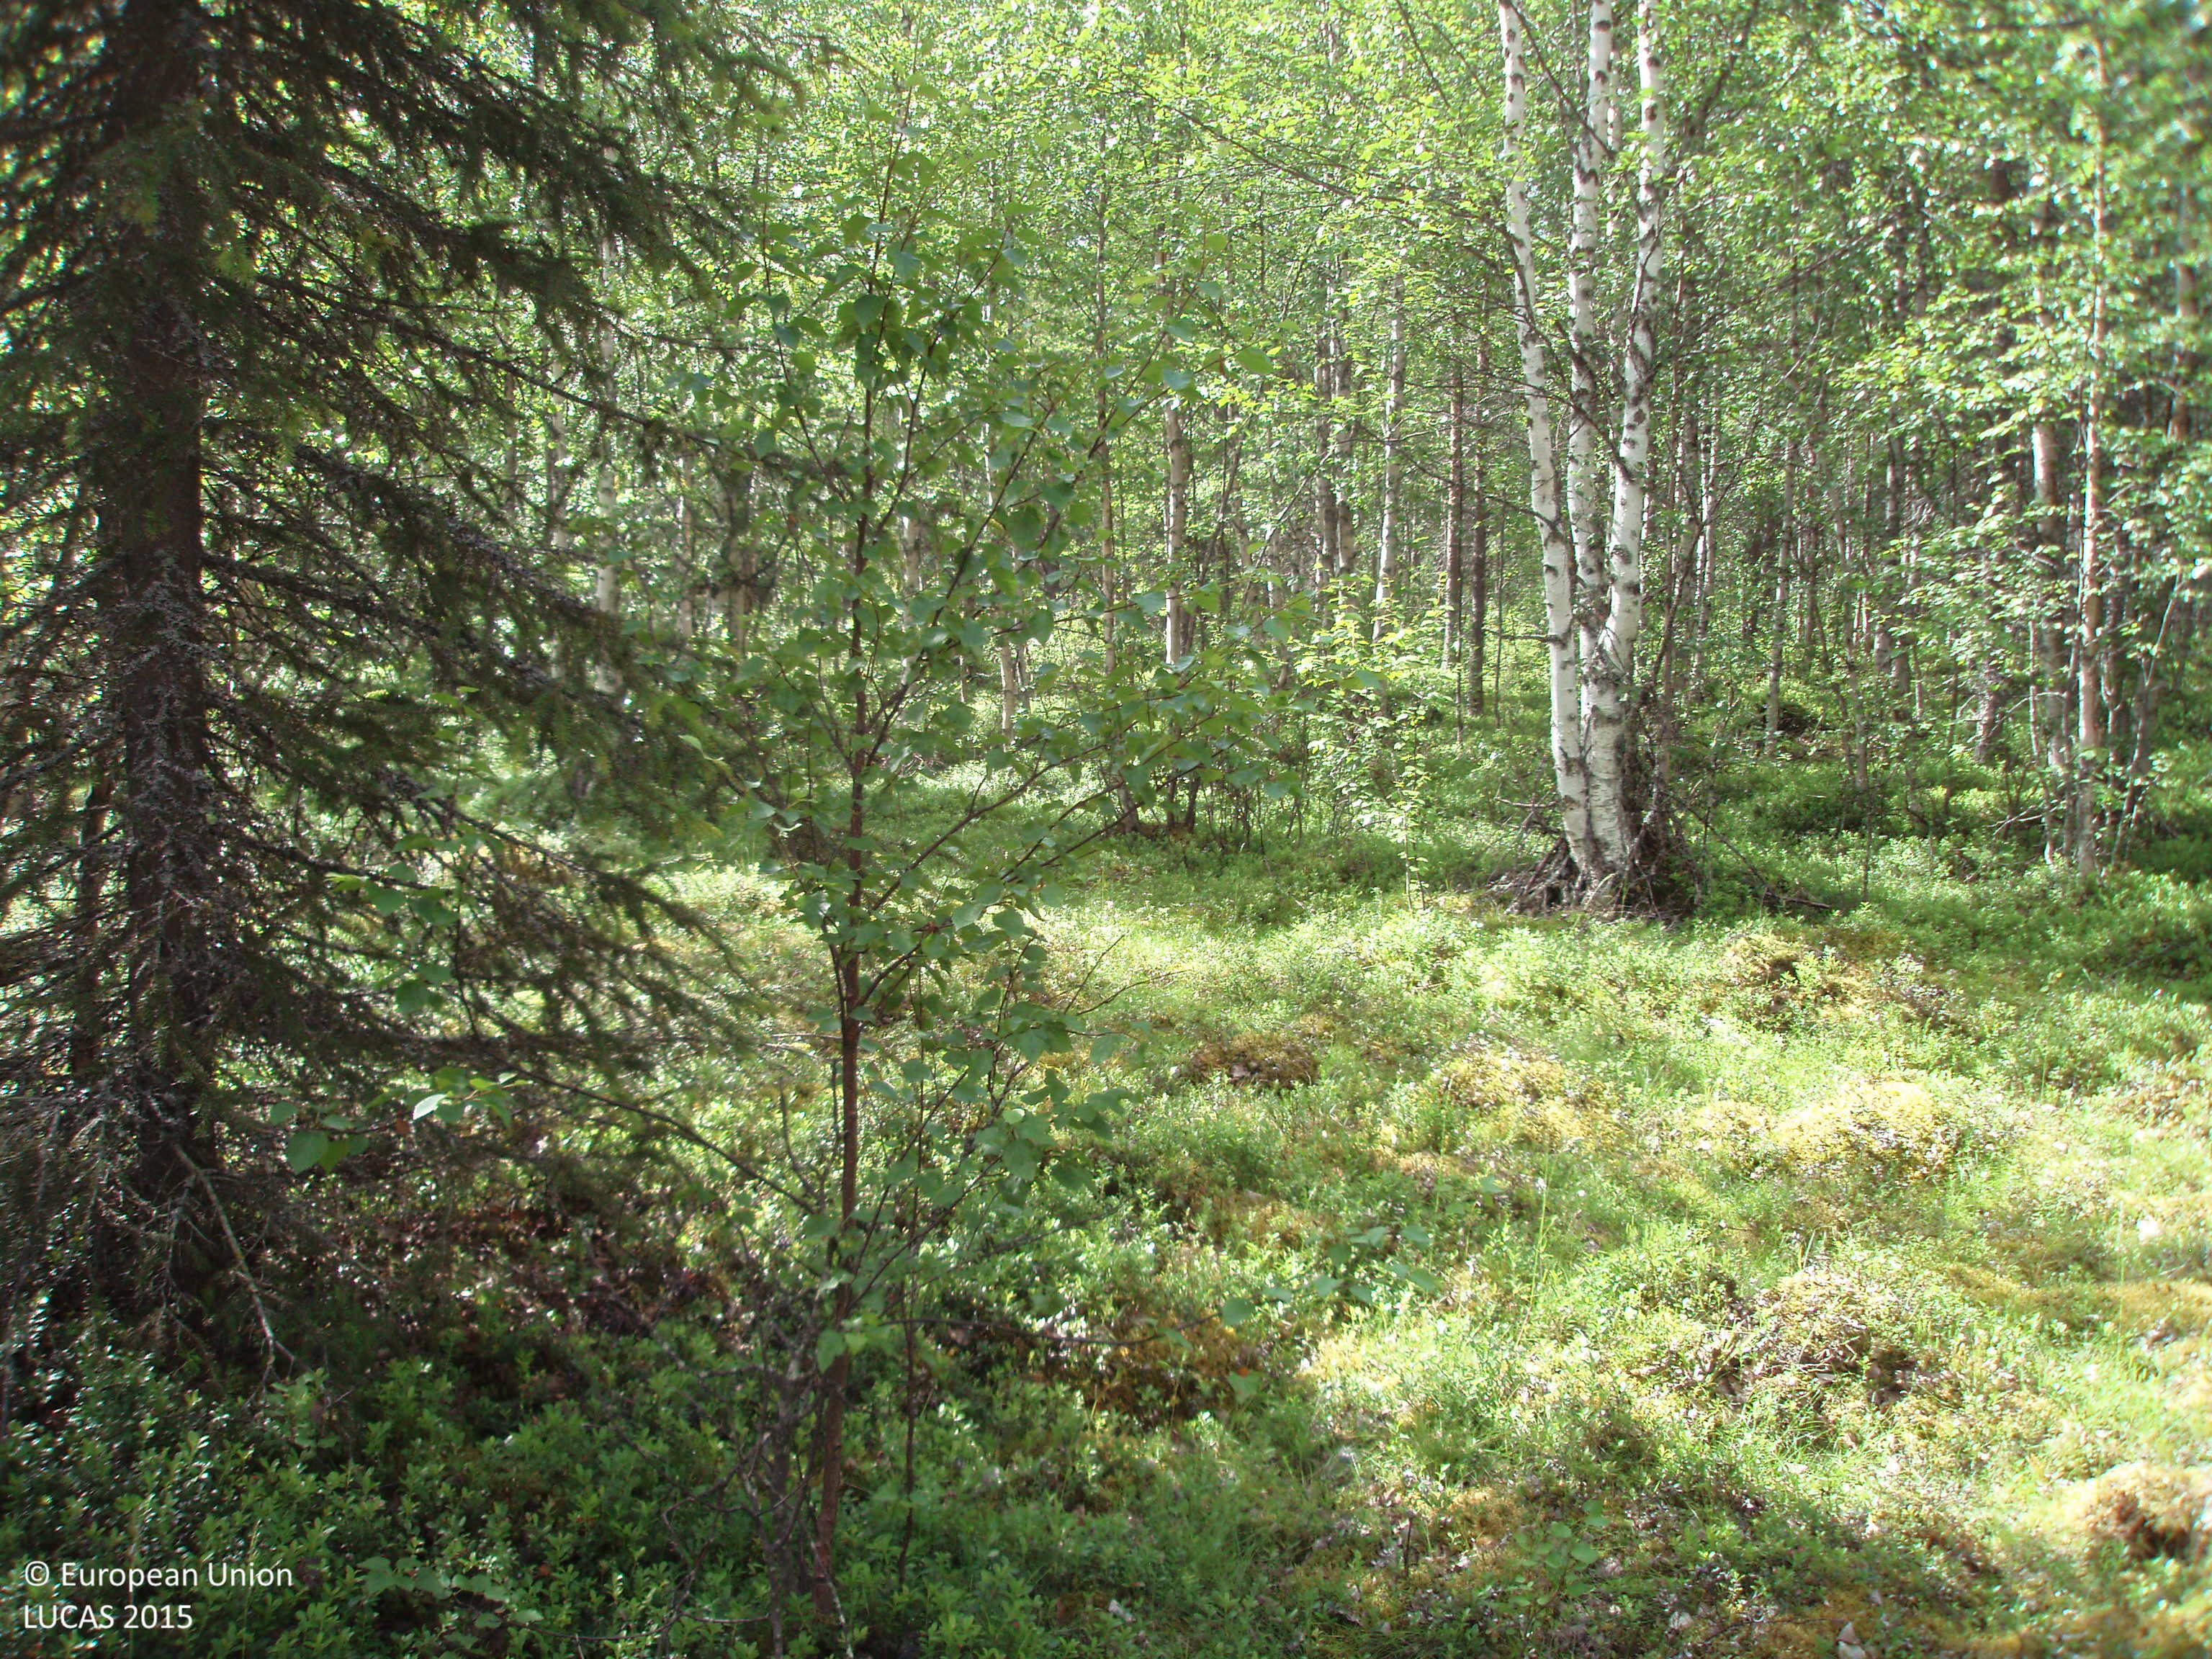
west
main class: Woodland
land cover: Broadleaved woodland
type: boreal forest
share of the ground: > 75 %
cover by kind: broadleaved forest trees 75 %, shrubs 20 %, coniferous forest trees 5 %
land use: Forestry
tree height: > 5 m
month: July
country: FI
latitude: 66.9529
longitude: 28.2357
